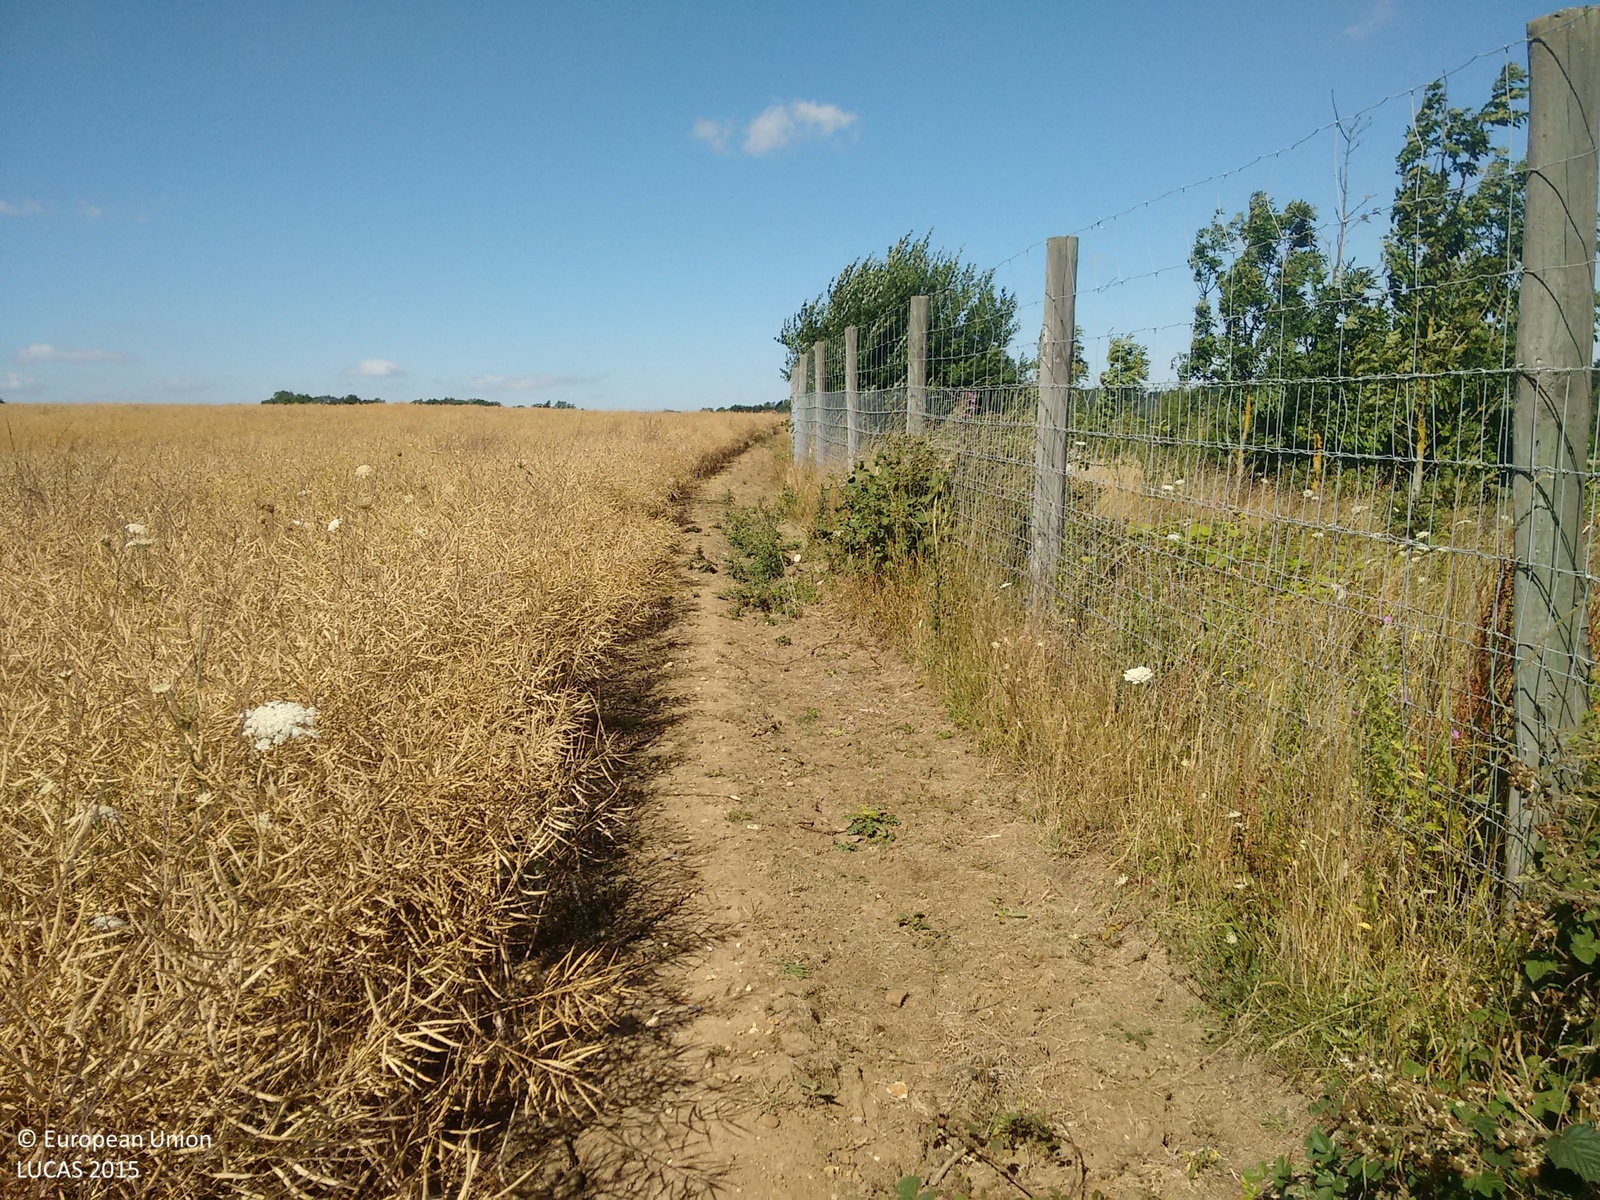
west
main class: Cropland
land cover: Rape and turnip rape
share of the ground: > 75 %
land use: Agriculture (excluding fallow land and kitchen gardens)
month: July
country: GB
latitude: 51.8586
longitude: 0.3732
